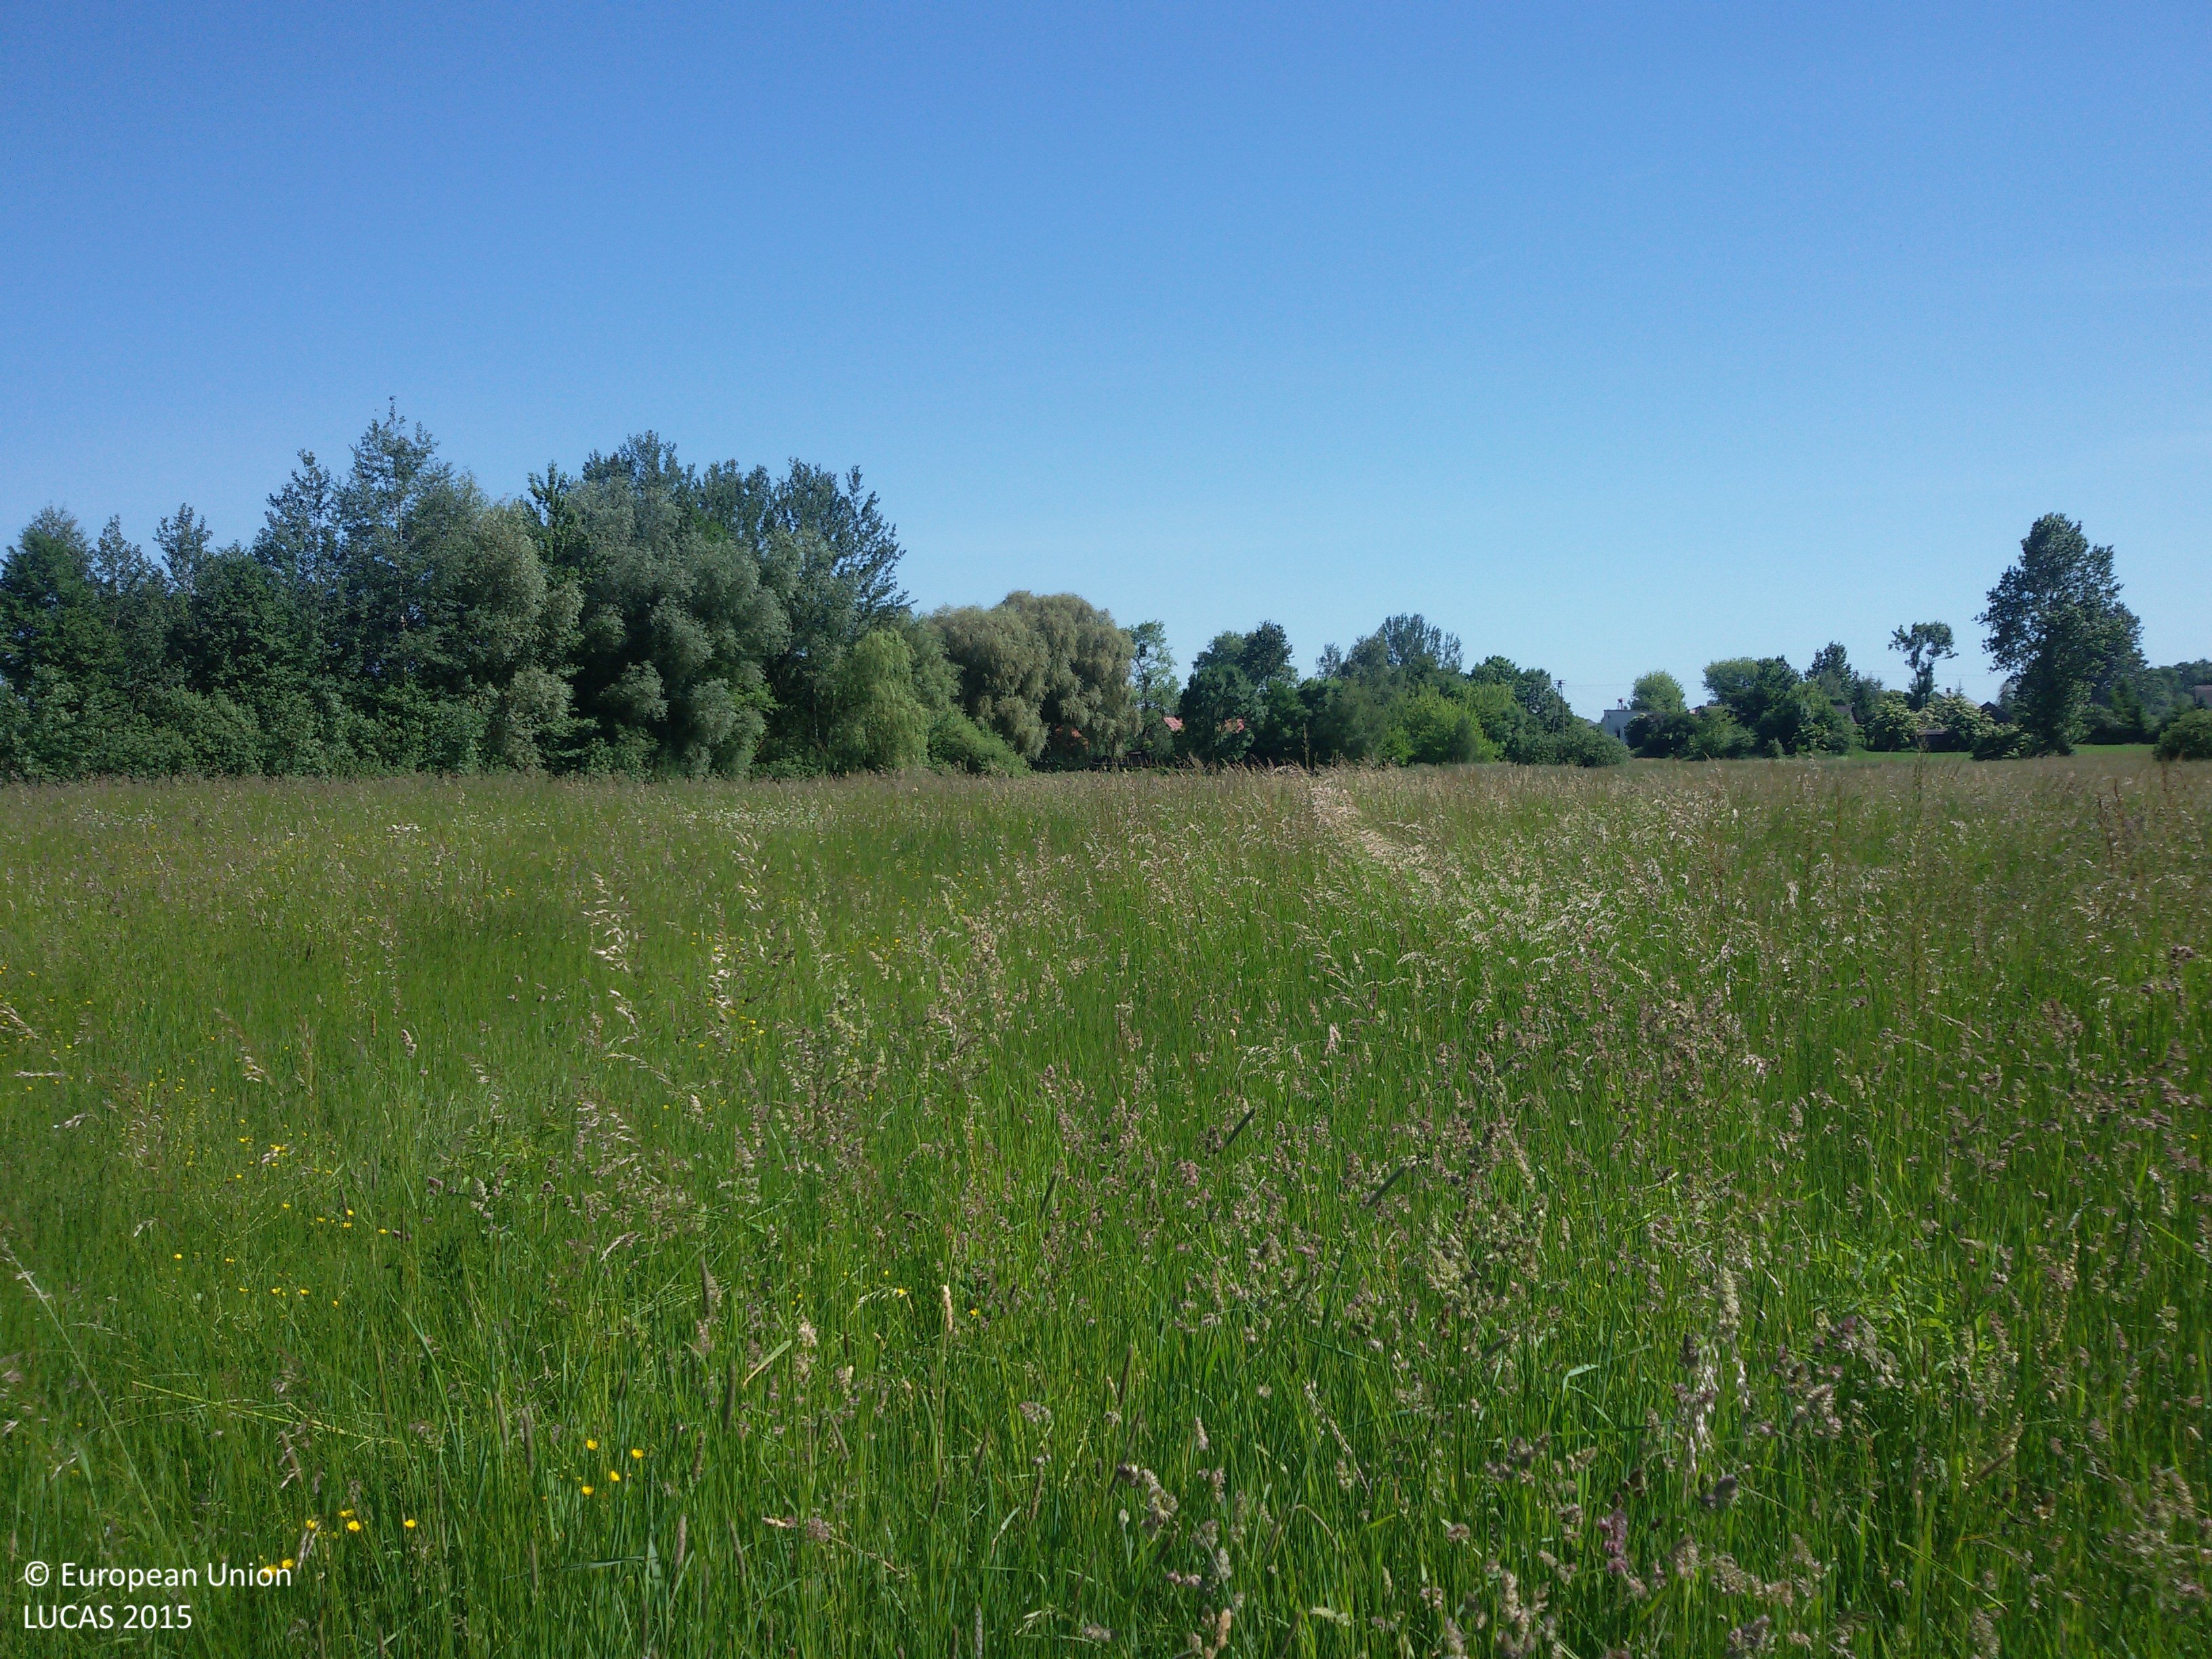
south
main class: Grassland
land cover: Grassland without tree/shrub cover
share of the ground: > 75 %
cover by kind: herbaceous plants 100 %
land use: Semi-natural and natural areas not in use
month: June
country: PL
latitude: 51.2160
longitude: 22.8862
